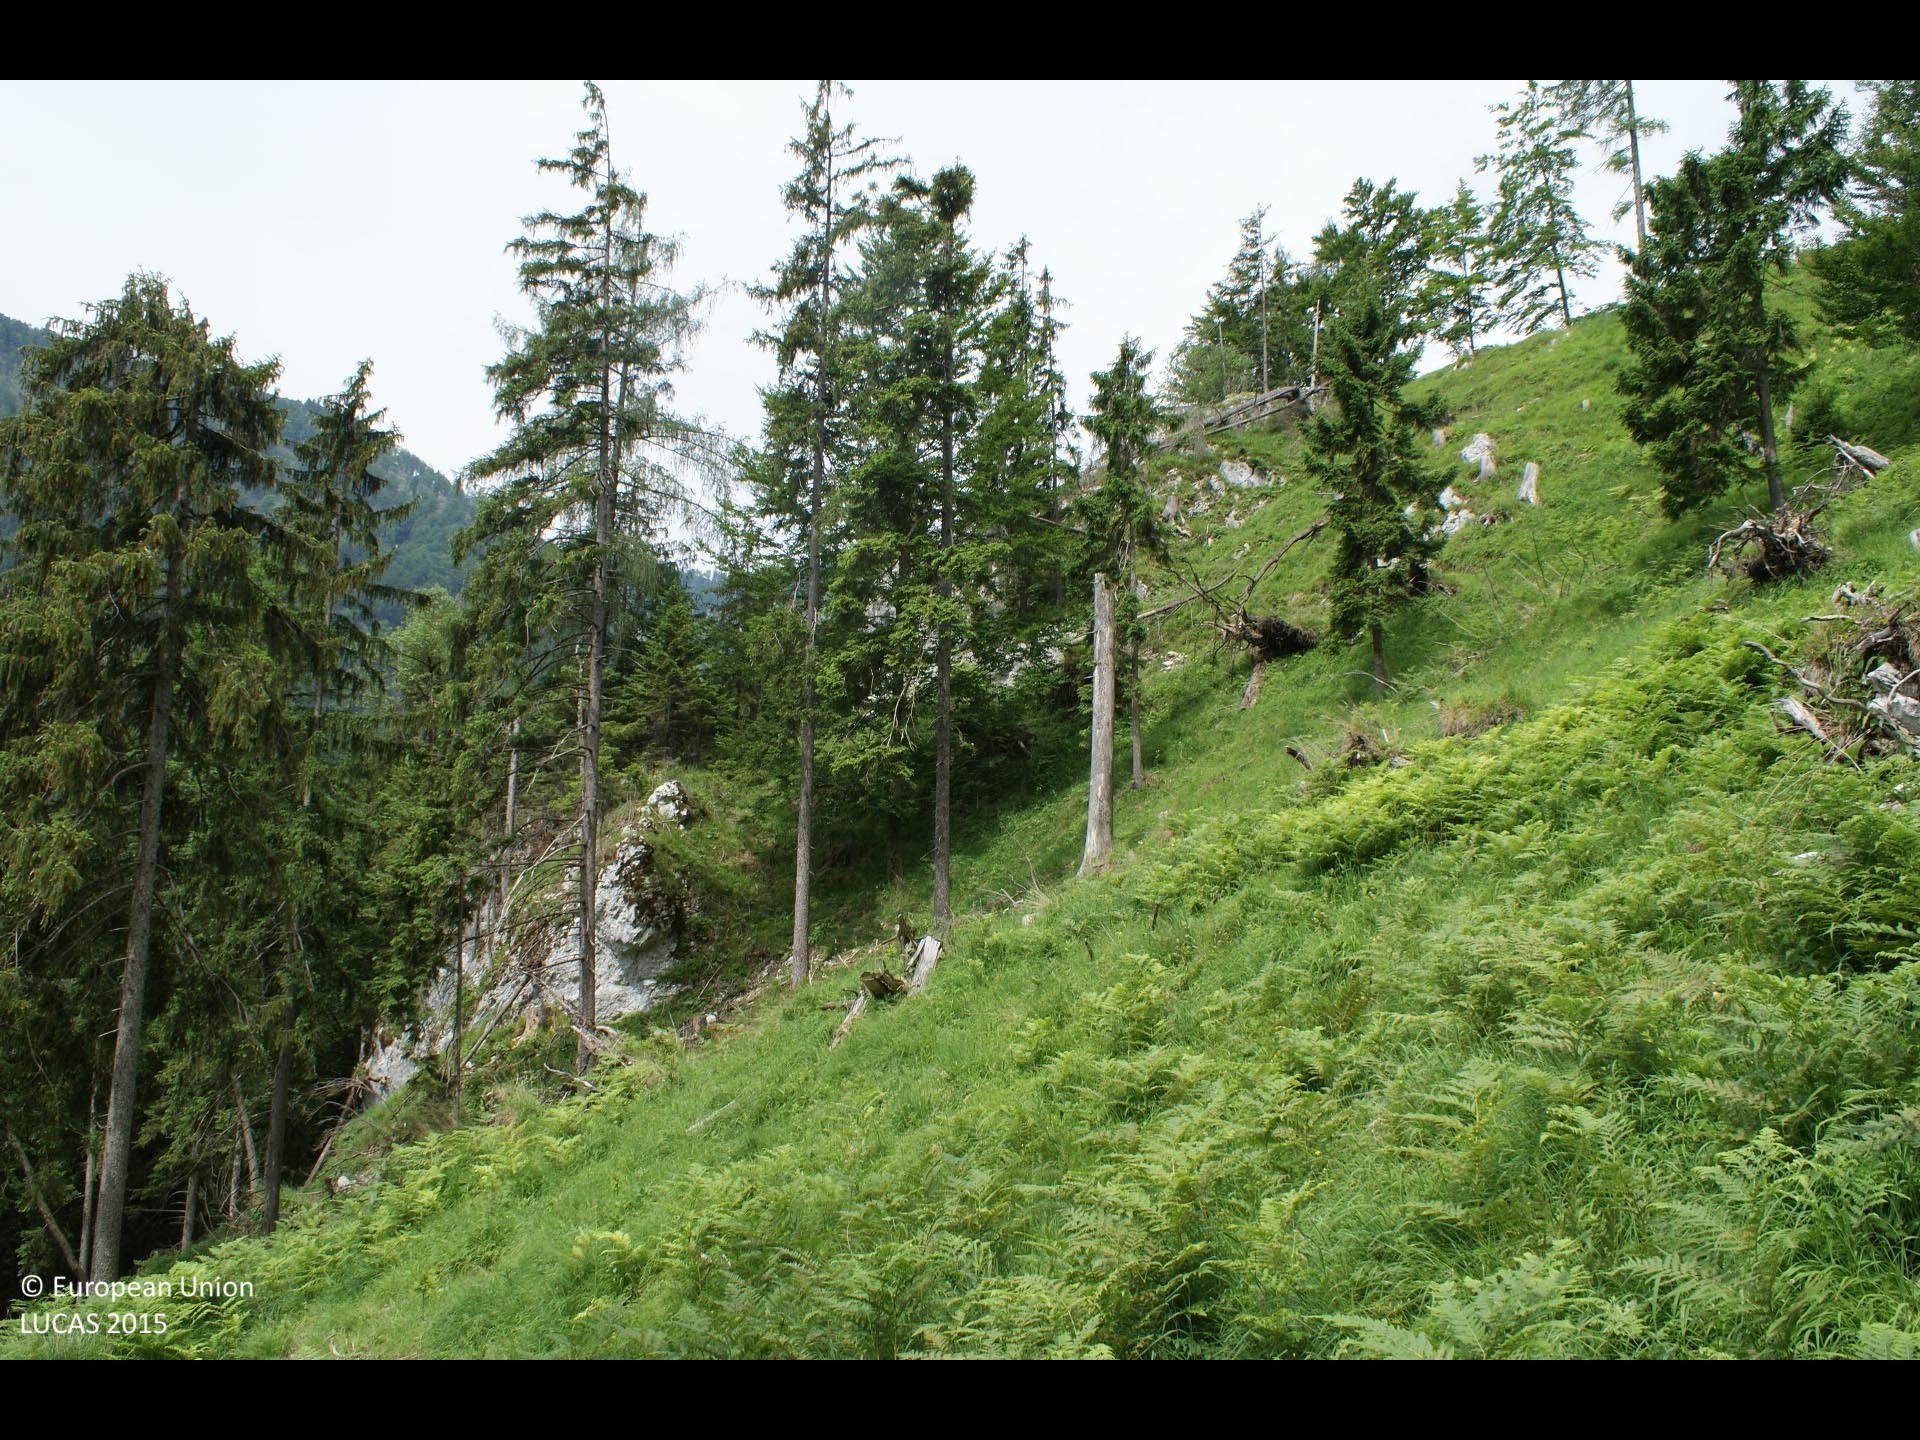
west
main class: Grassland
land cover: Spontaneously vegetated surfaces
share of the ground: > 75 %
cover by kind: herbaceous plants 95 %, shrubs 5 %
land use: Forestry
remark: Clear cut
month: June
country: AT
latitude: 47.8220
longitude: 14.1265
